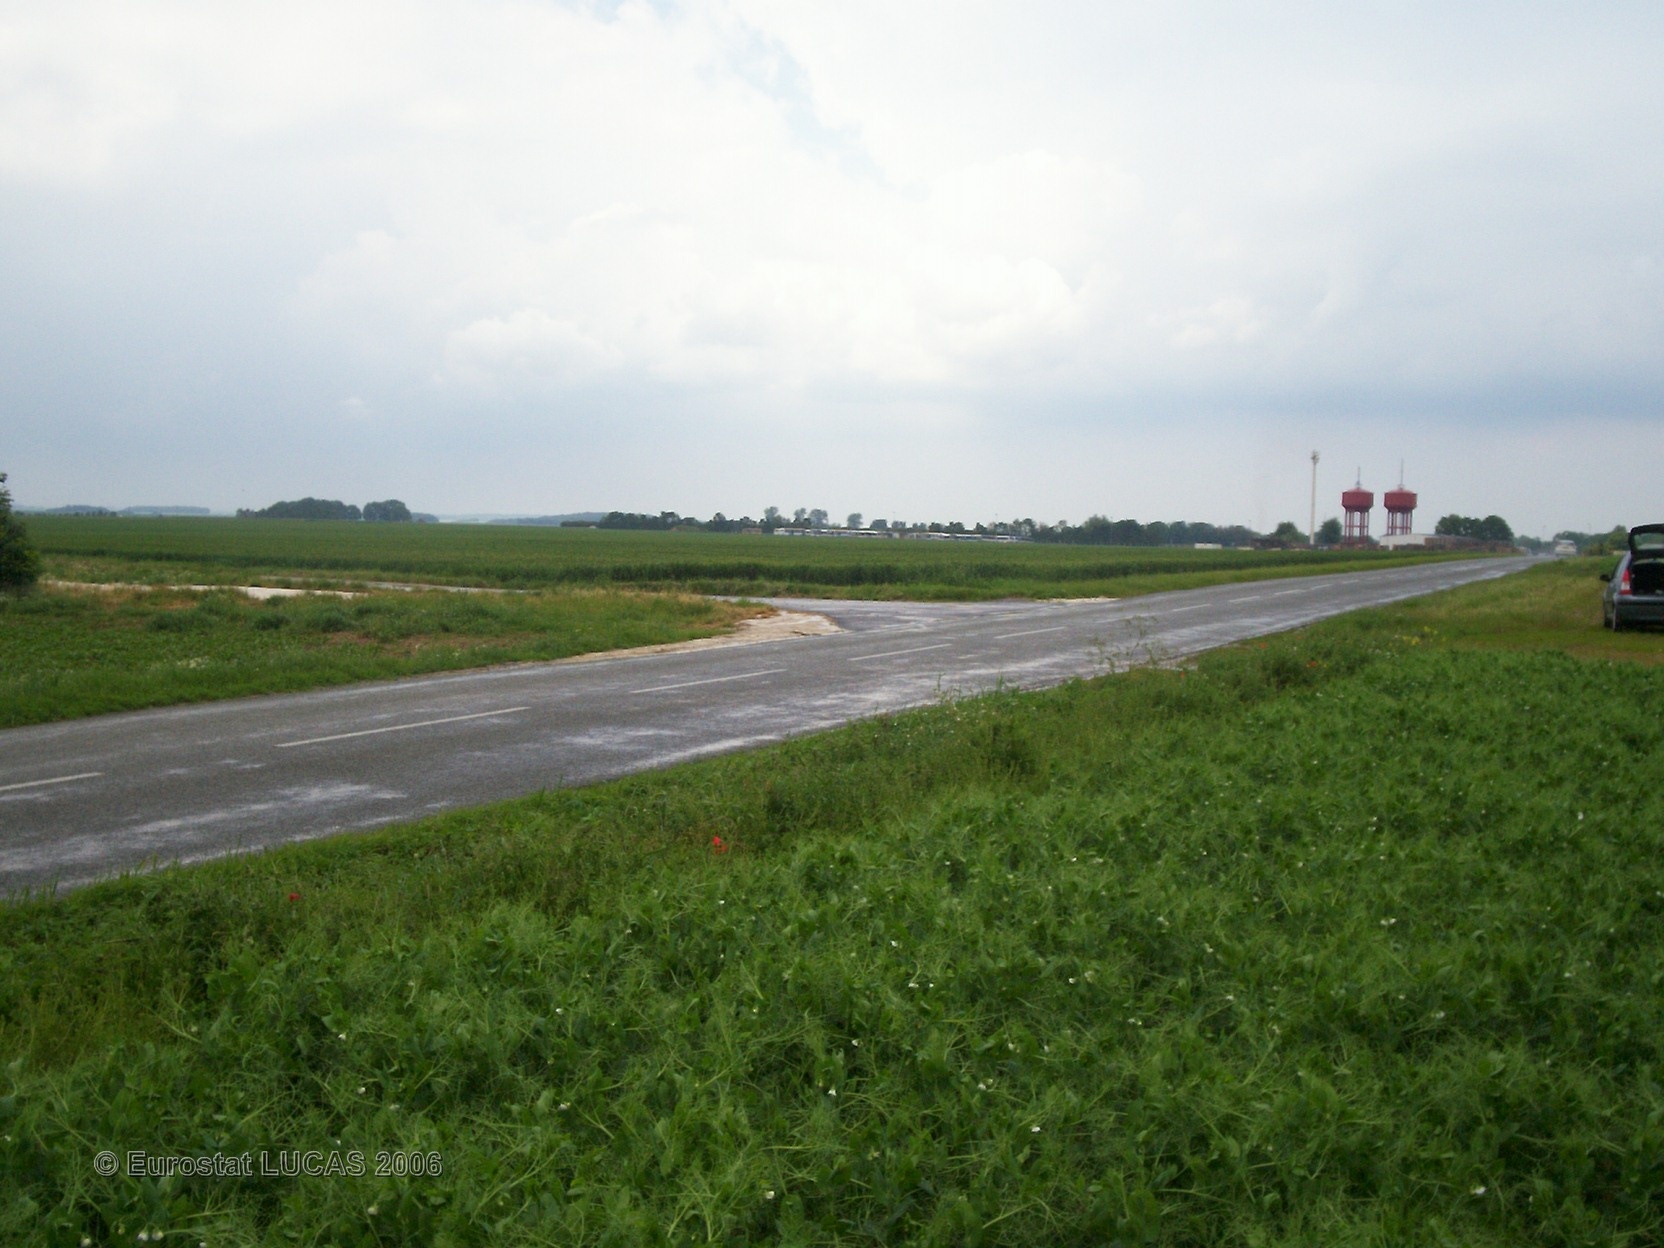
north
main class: Cropland
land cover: Dry pulses
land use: Agriculture (excluding fallow land and kitchen gardens)
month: June
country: FR
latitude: 49.7641
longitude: 2.6165
